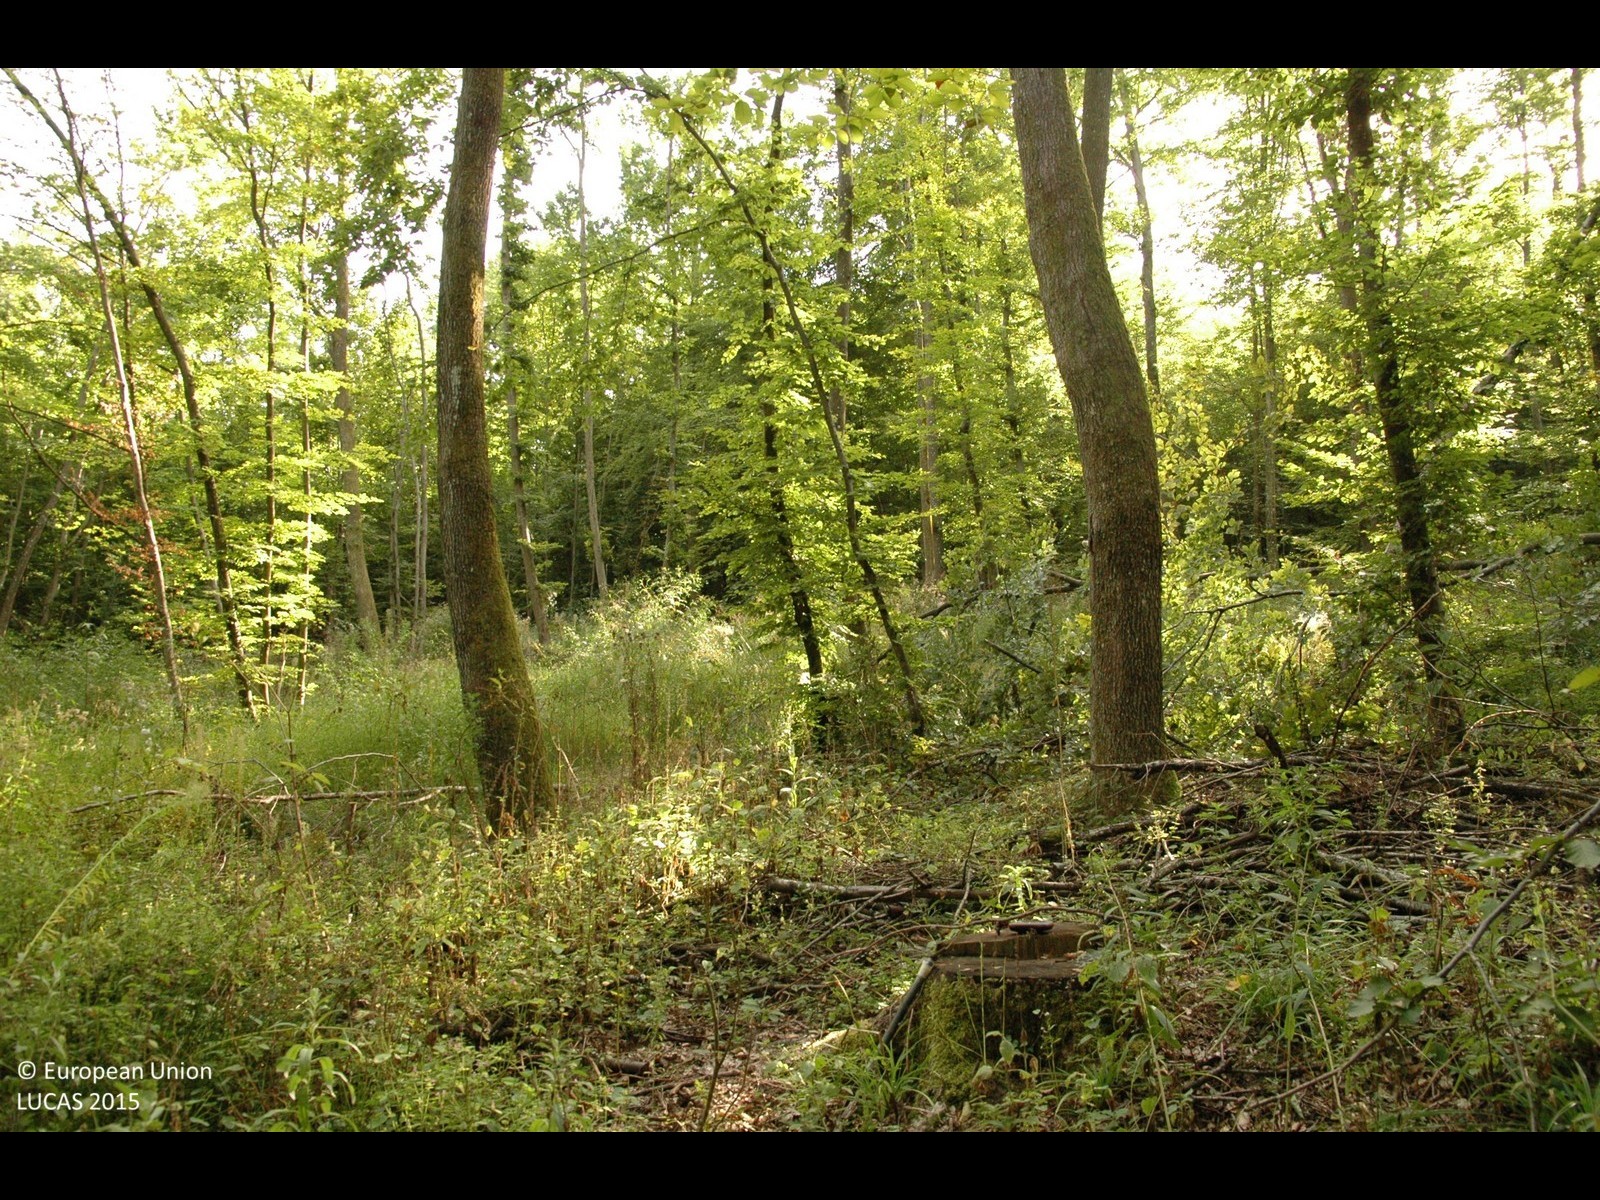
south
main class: Woodland
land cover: Broadleaved woodland
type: mesophytic deciduous forest
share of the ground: > 75 %
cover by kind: broadleaved forest trees 100 %
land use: Forestry
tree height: > 5 m
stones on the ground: < 10 %
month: September
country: HR
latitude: 45.6472
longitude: 15.8867
